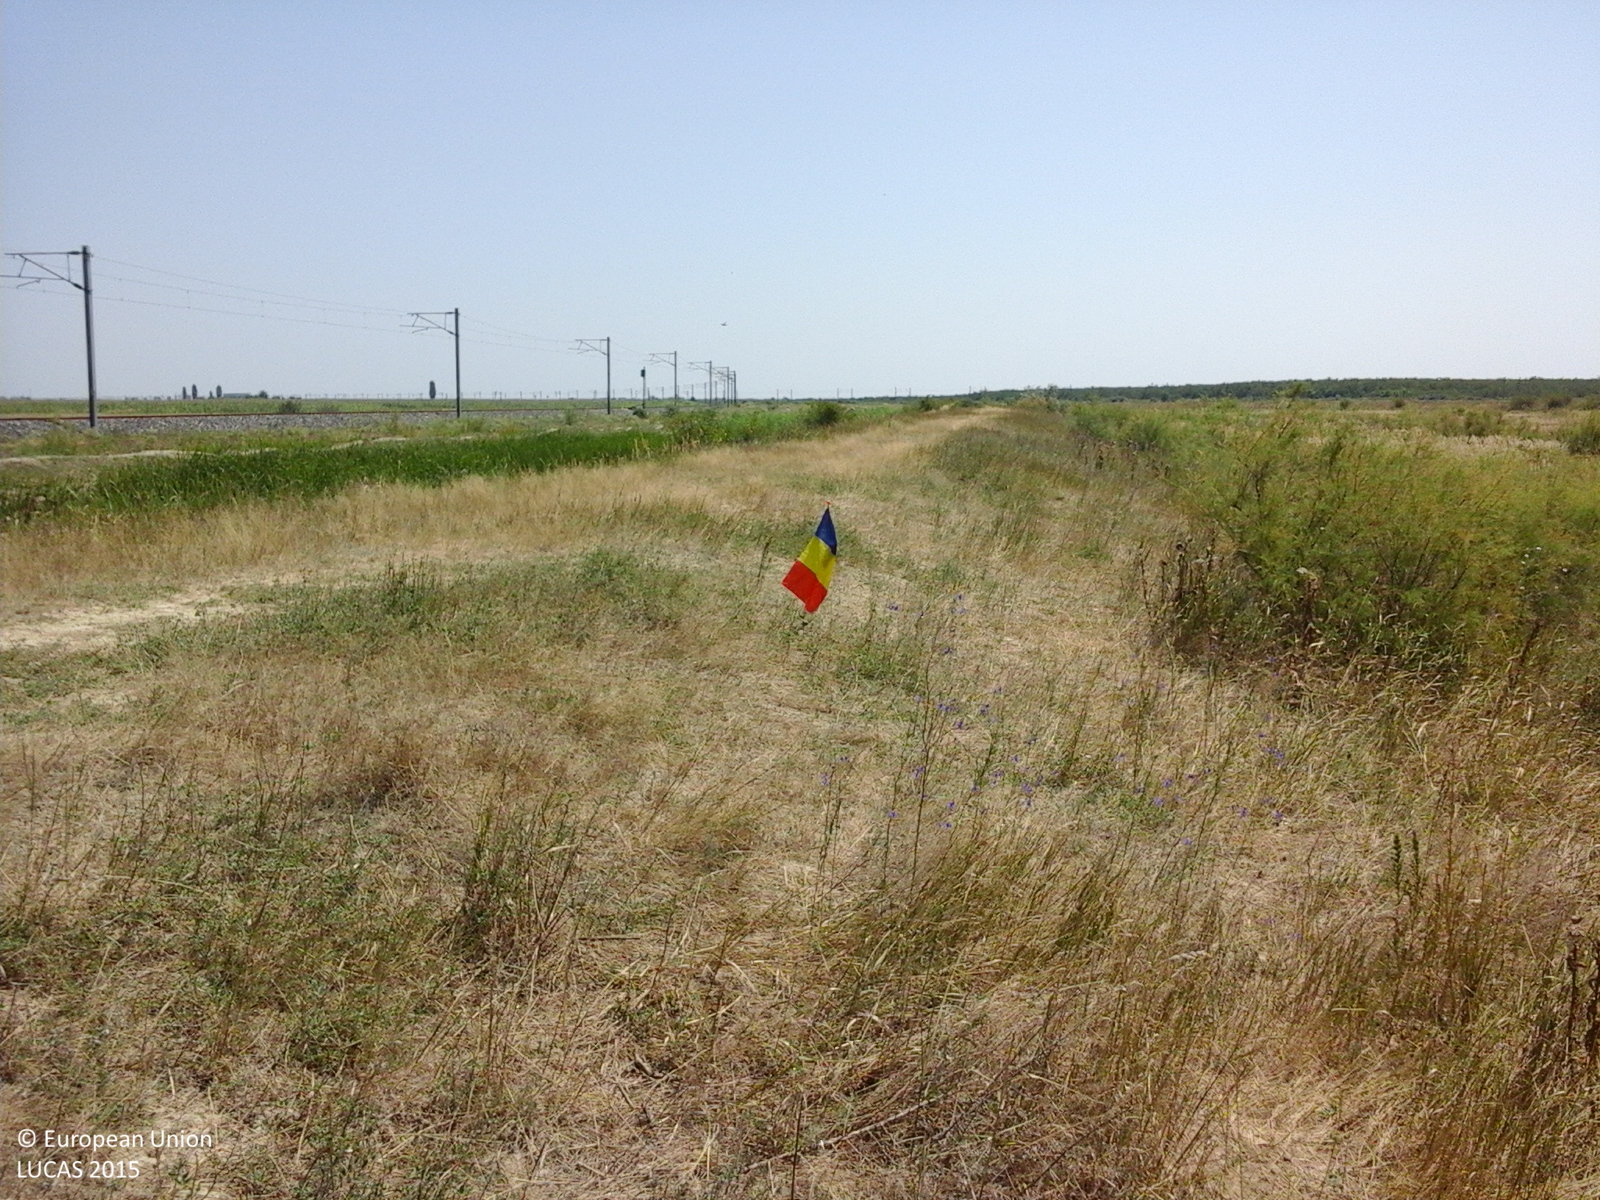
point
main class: Grassland
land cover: Spontaneously vegetated surfaces
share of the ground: > 75 %
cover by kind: herbaceous plants 100 %
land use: Fallow land
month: July
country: RO
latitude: 45.0733
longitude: 27.1993
